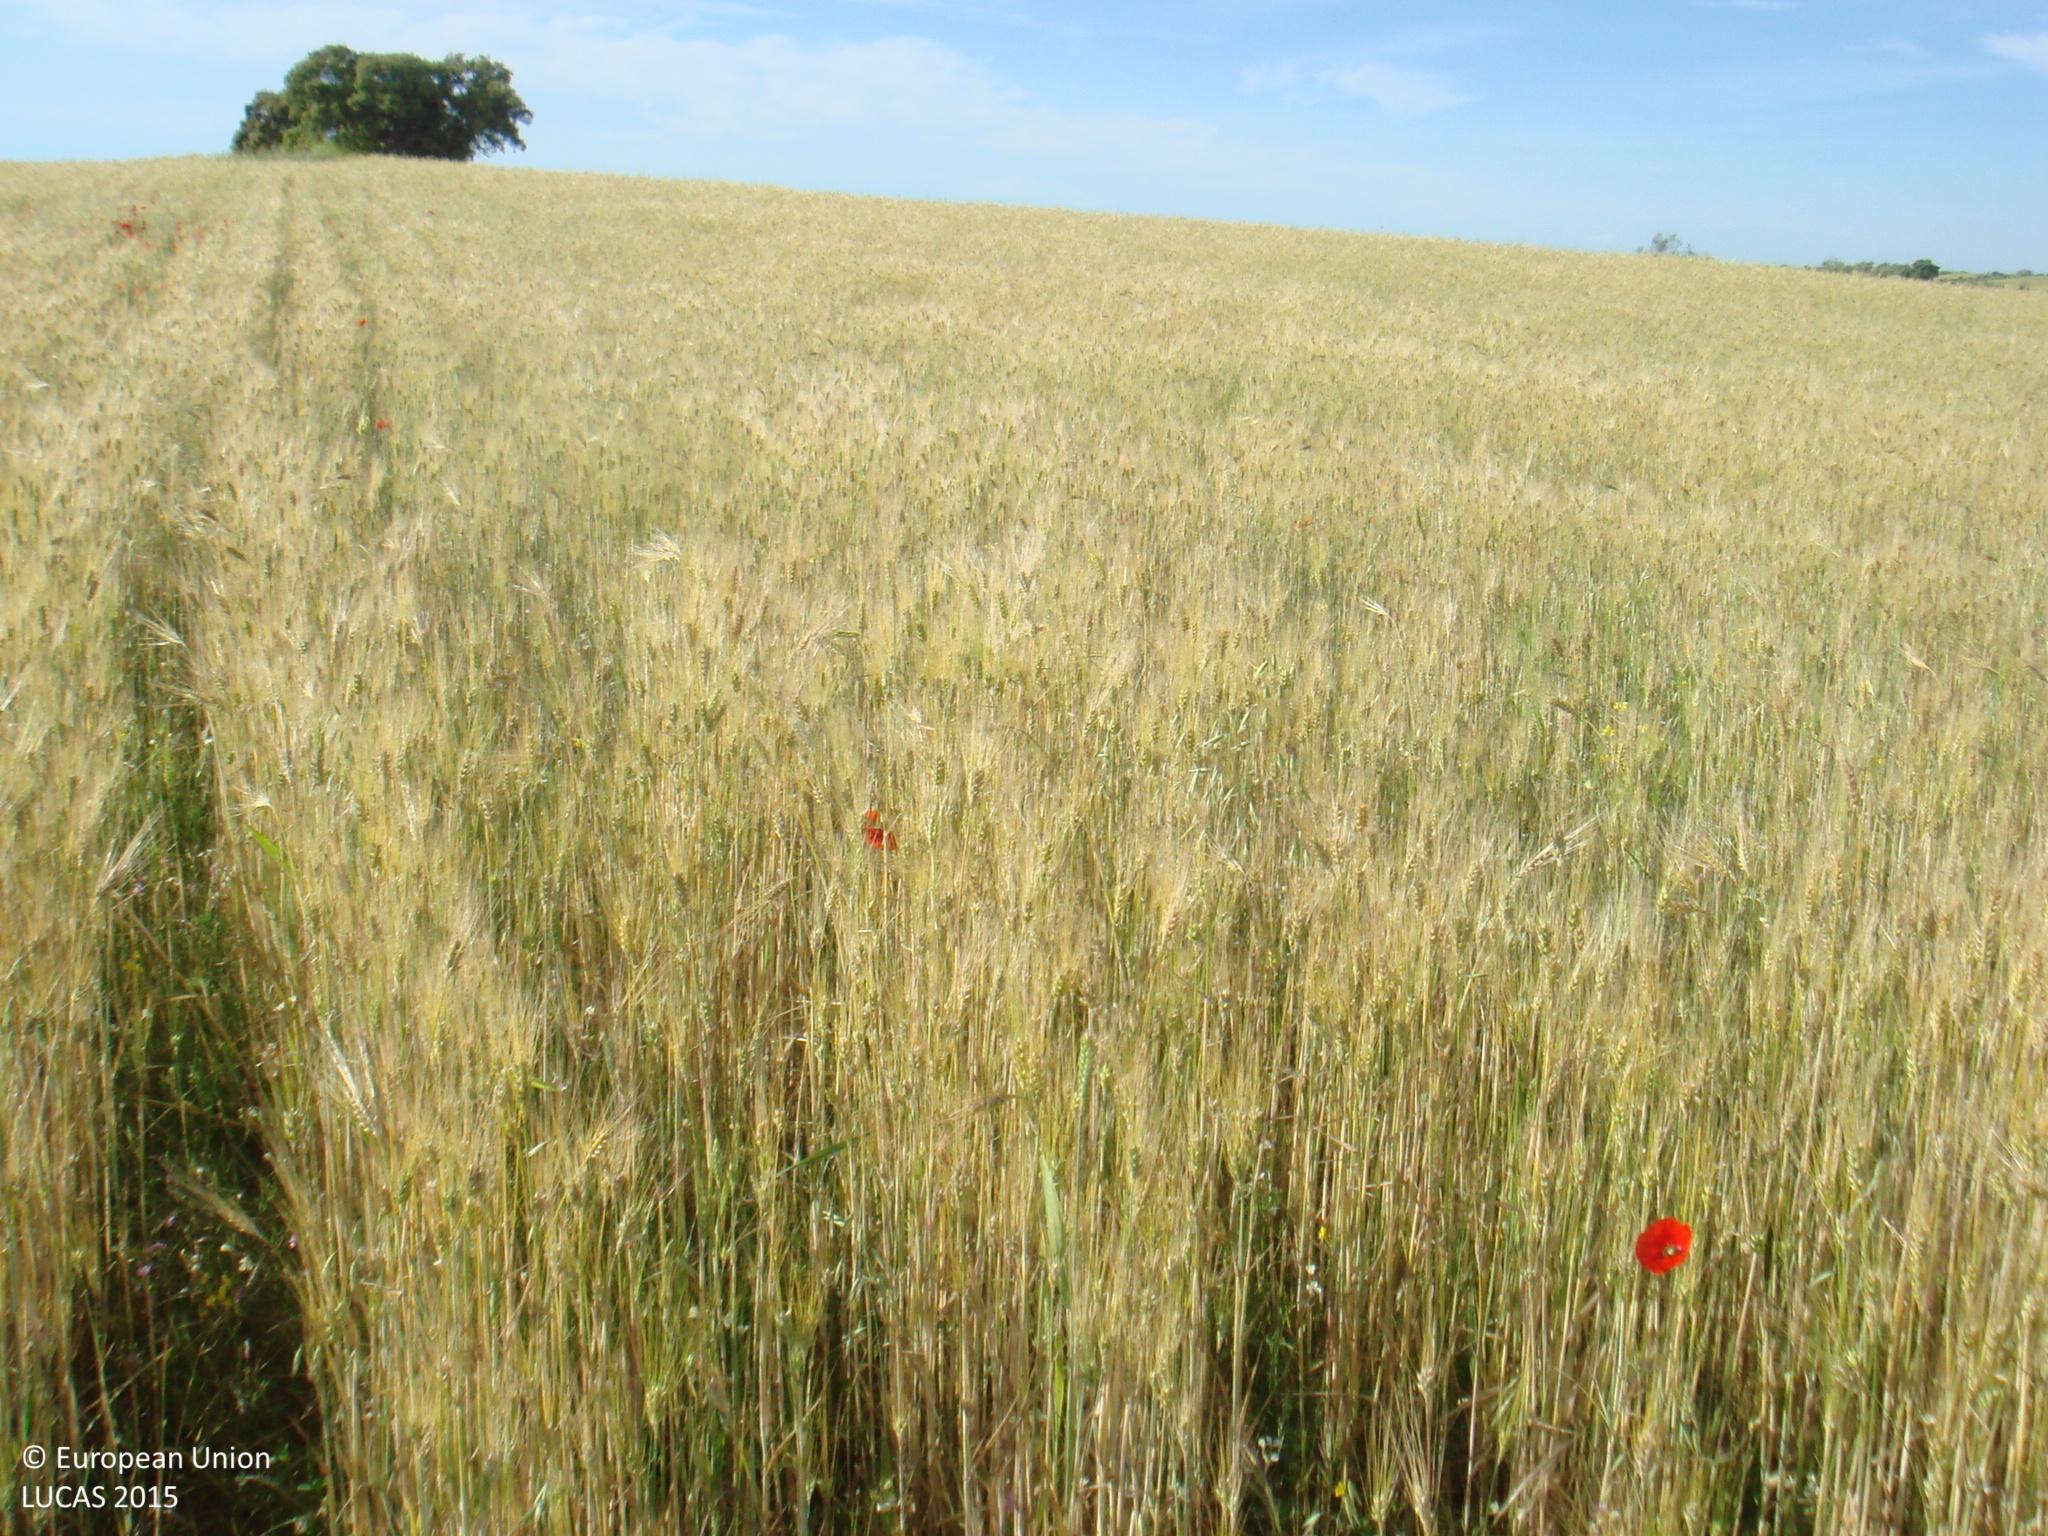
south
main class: Cropland
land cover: Durum wheat
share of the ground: > 75 %
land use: Agriculture (excluding fallow land and kitchen gardens)
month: May
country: ES
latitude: 38.4379
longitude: -5.0468
